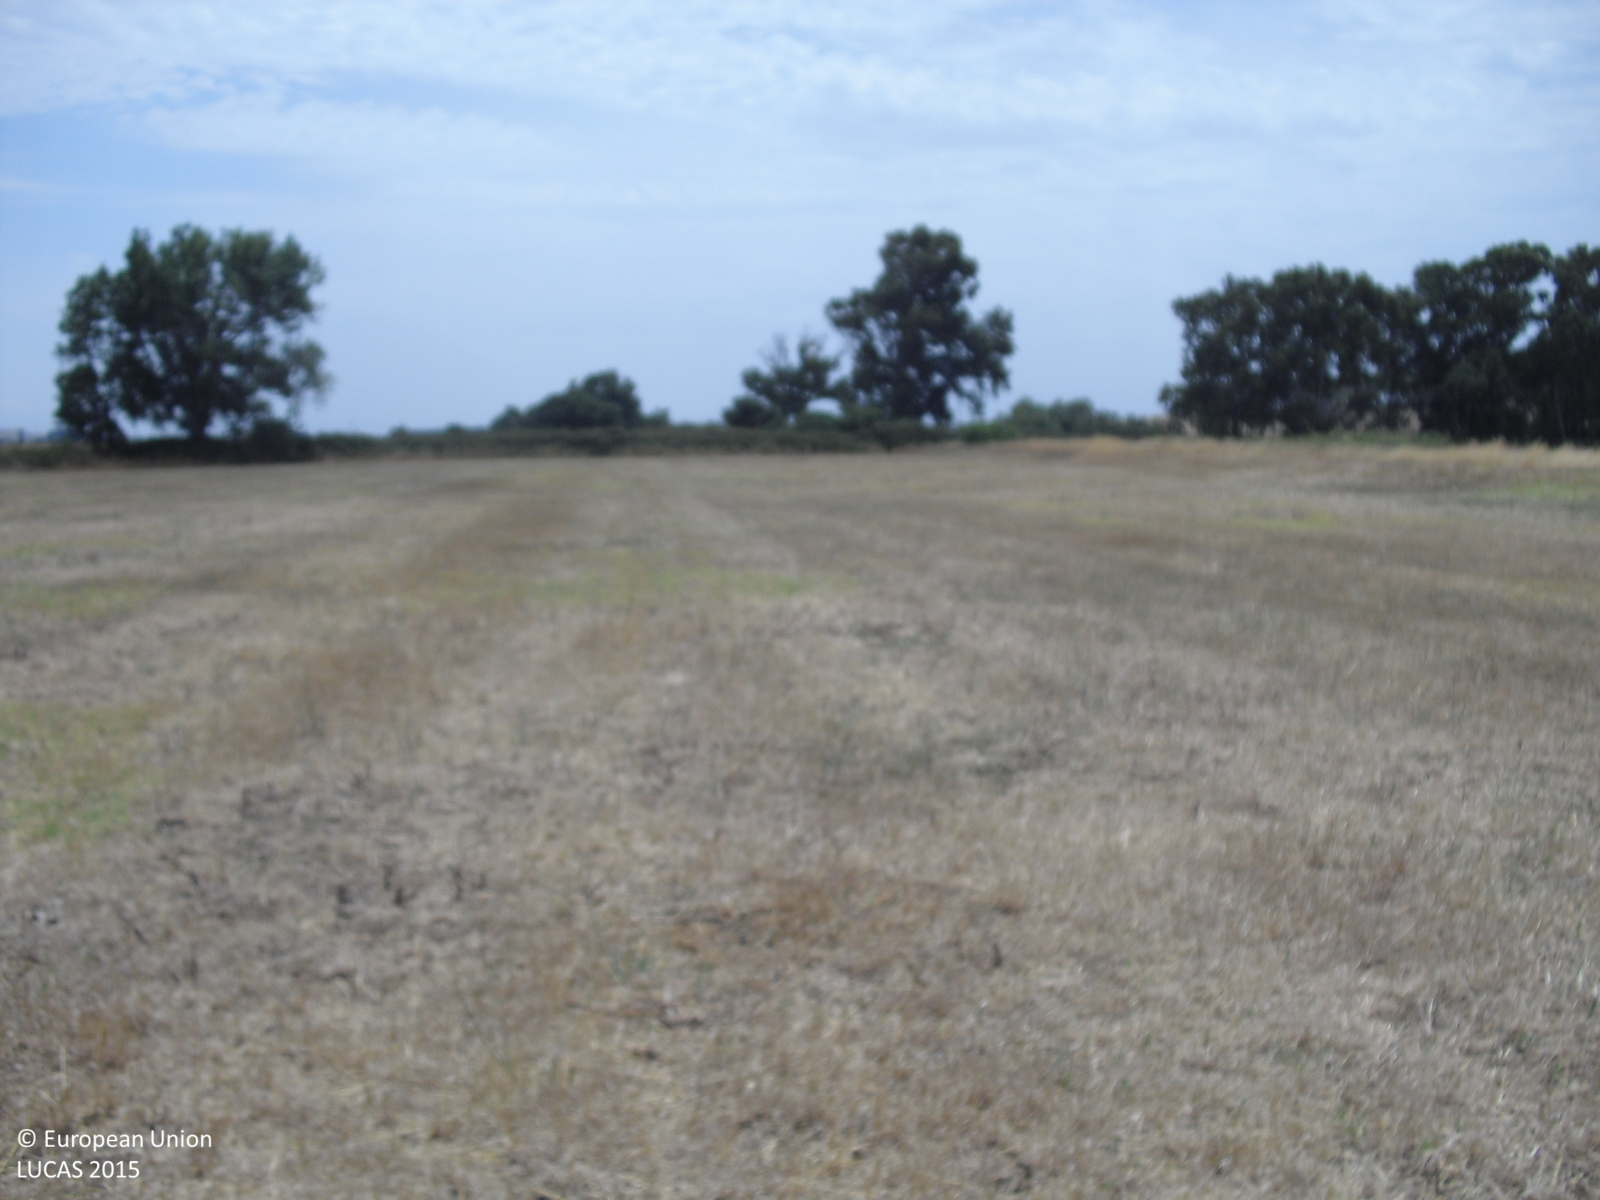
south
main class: Grassland
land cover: Spontaneously vegetated surfaces
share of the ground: 25 - 50 %
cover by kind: unconsolidated bare surface 65 %, herbaceous plants 35 %
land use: Agriculture (excluding fallow land and kitchen gardens)
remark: Harvested field
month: July
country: ES
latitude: 36.0585
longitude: -5.6344
